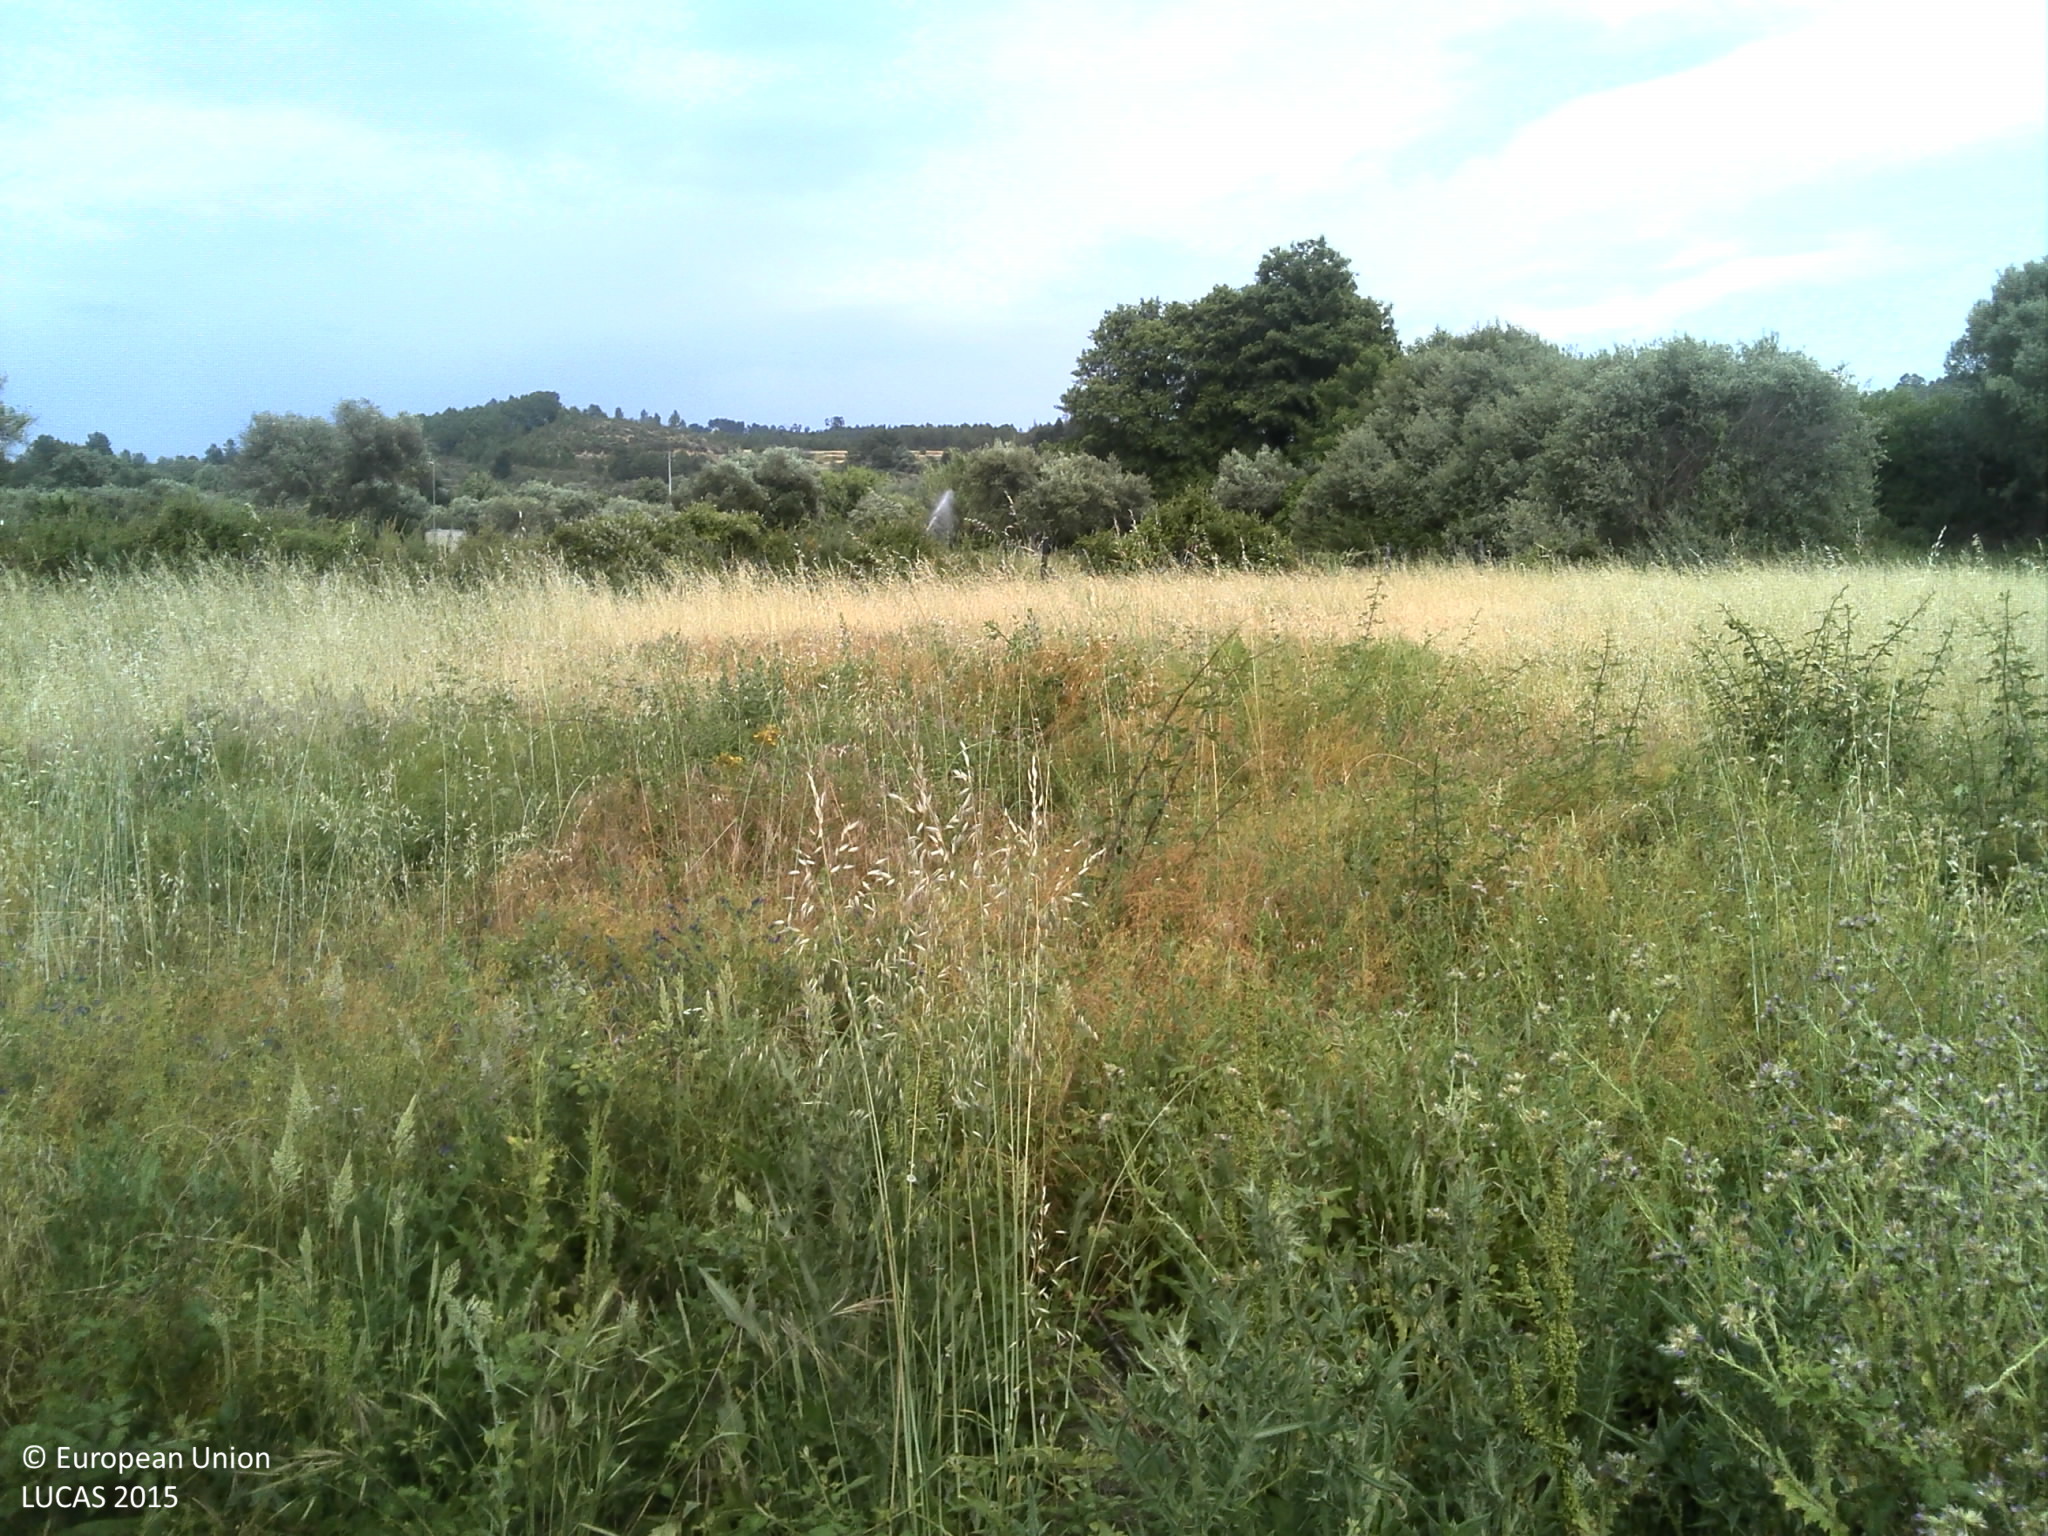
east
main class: Shrubland
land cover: Shrubland without tree cover
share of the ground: 50 - 75 %
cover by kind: shrubs 60 %, herbaceous plants 25 %, unconsolidated bare surface 10 %
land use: Agriculture (excluding fallow land and kitchen gardens)
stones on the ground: 10 - 25 %
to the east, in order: Shrubland without tree cover; Grassland without tree/shrub cover; Fences; Rivers and streams; Grassland without tree/shrub cover; Olive groves; Shruby margins; Rivers and streams; Shruby margins; Grassland without tree/shrub cover; Olive groves; Grassland without tree/shrub cover; Olive groves; Grass margins; Paved roads, cycling and walking lanes; Grass margins; Olive groves; Tracks; Fences; Olive groves
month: June
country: PT
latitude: 40.2619
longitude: -7.3286
